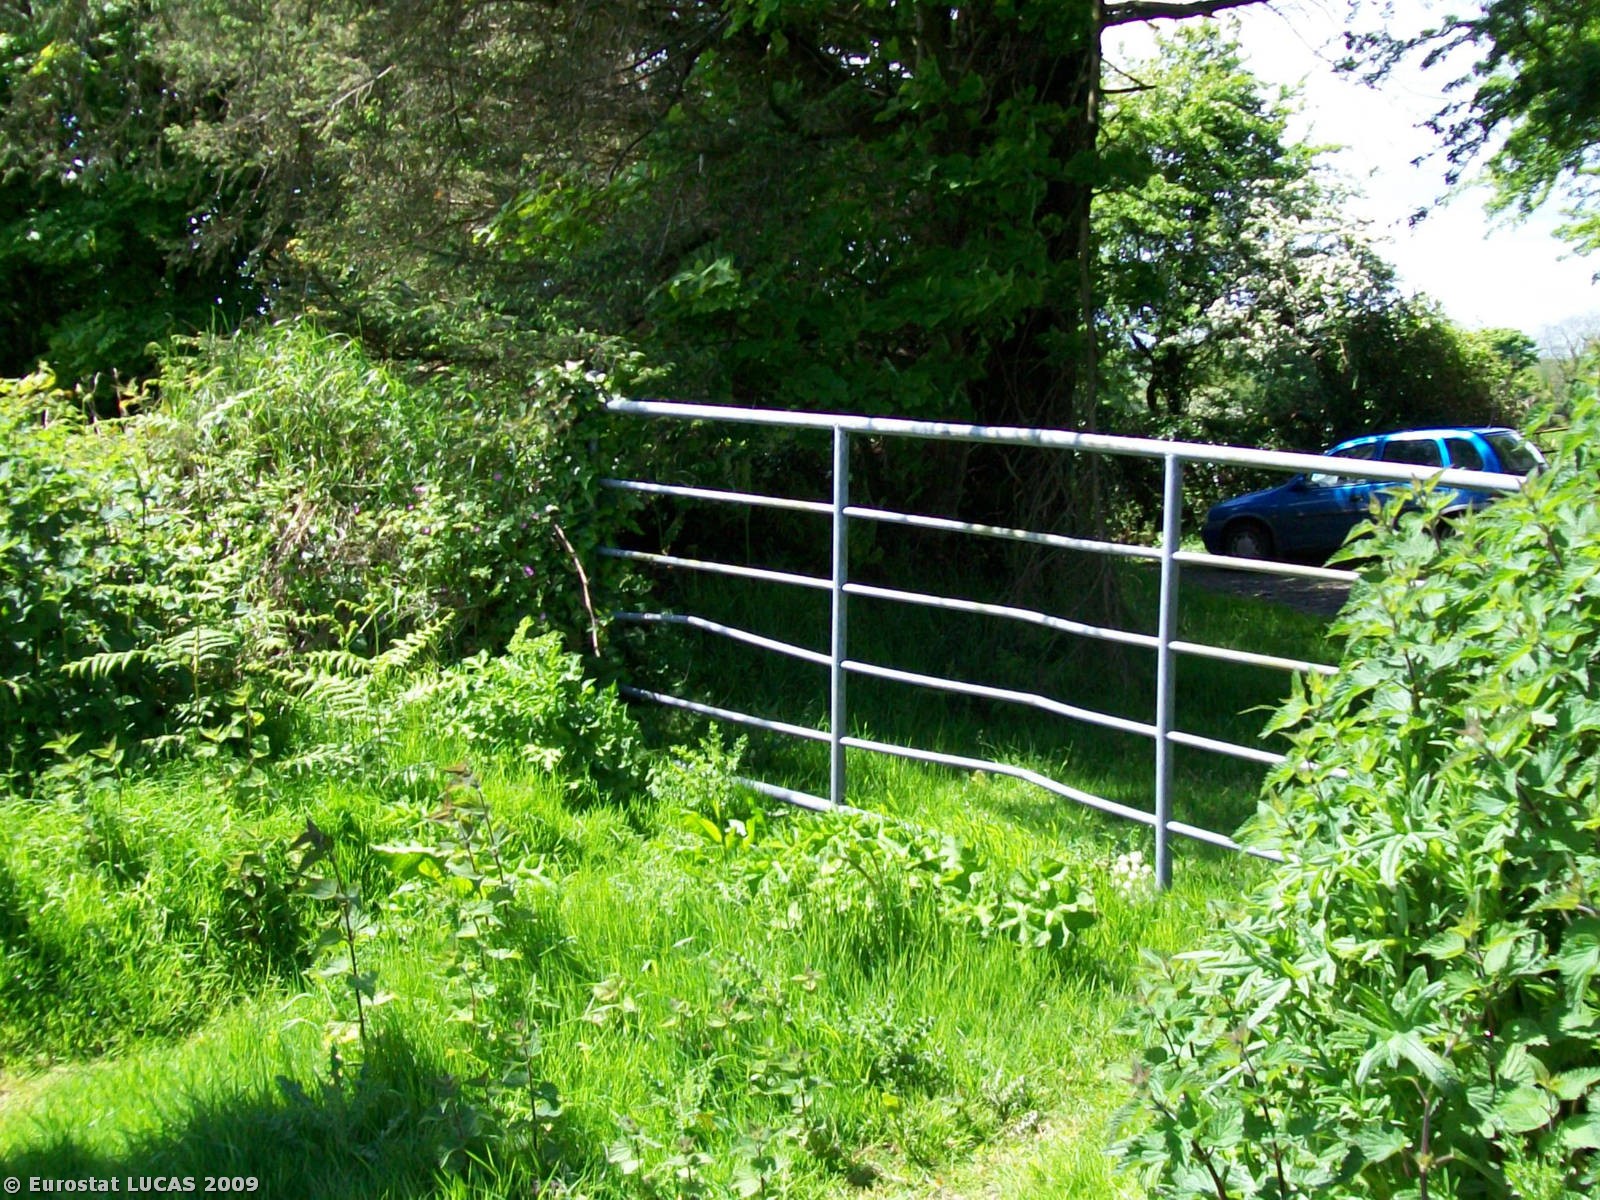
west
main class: Cropland
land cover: Common wheat
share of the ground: > 75 %
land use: Agriculture (excluding fallow land and kitchen gardens)
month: May
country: IE
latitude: 51.8321
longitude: -8.7037
